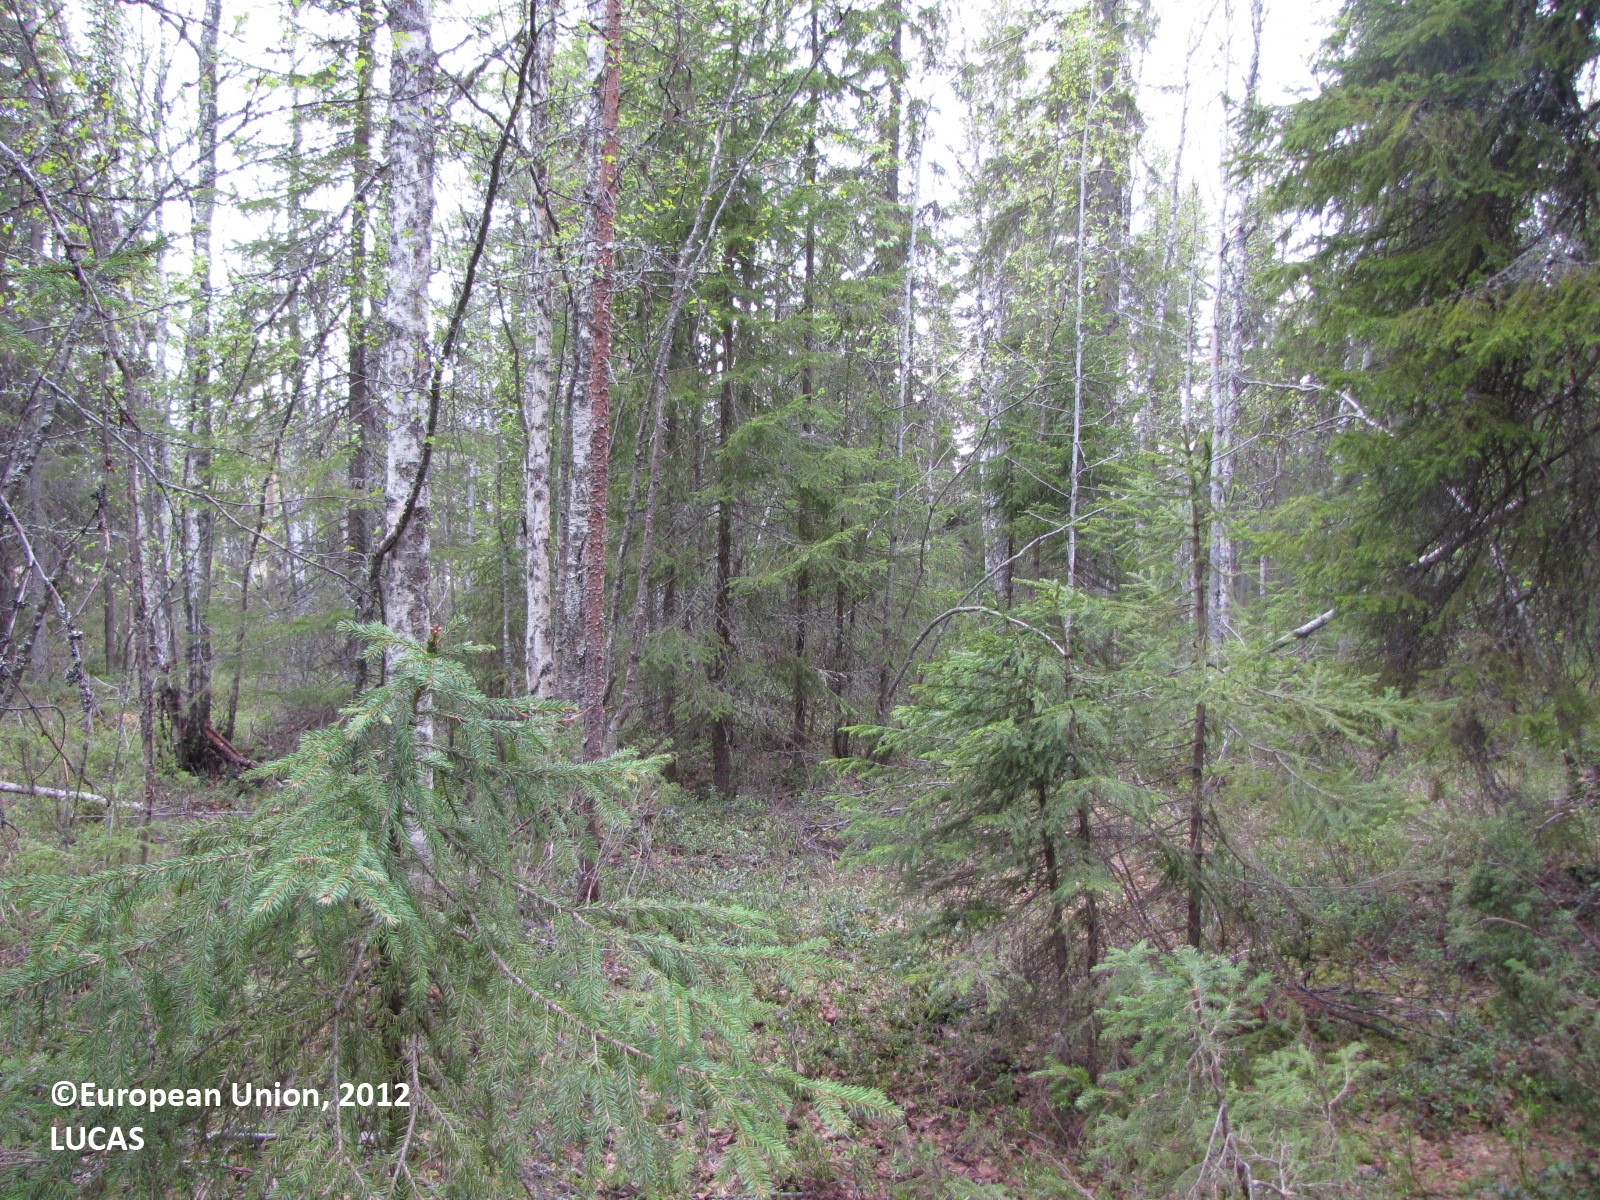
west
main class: Woodland
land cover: Spruce dominated mixed woodland
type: boreal forest
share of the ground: > 75 %
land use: Forestry
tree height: > 5 m
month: June
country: FI
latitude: 65.8323
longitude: 24.4782
